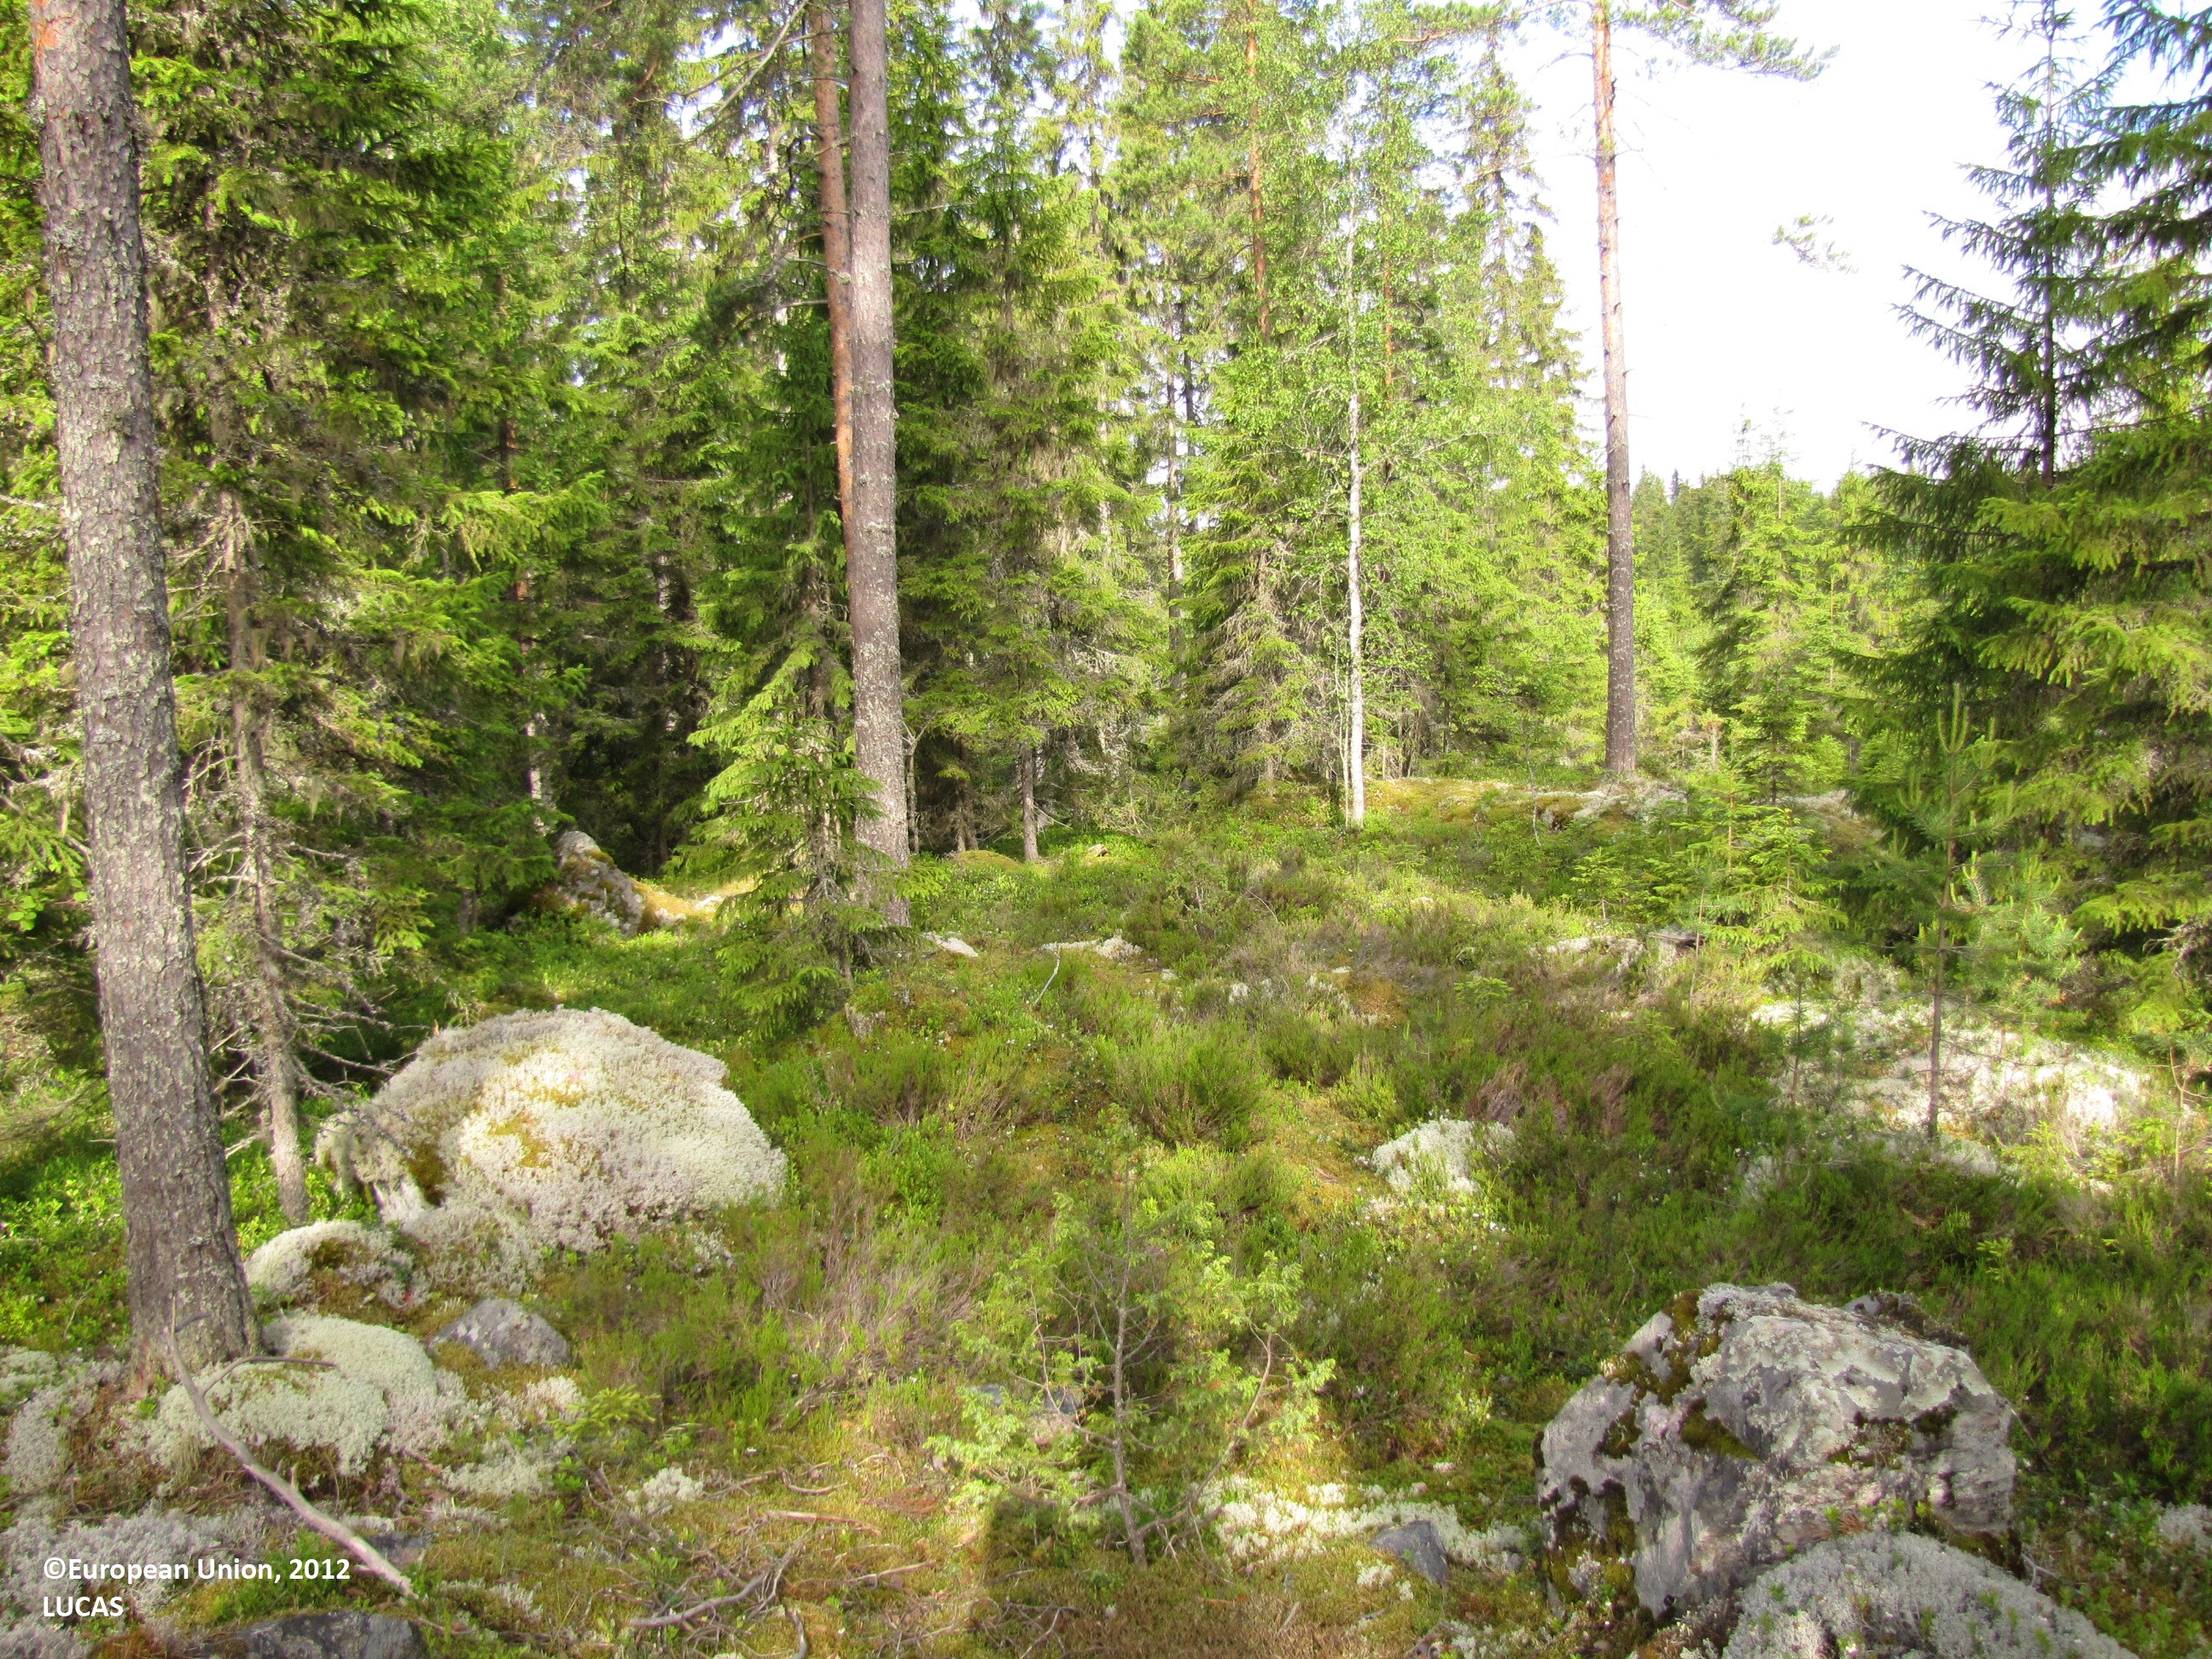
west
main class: Woodland
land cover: Pine dominated coniferous woodland
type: boreal forest
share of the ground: 50 - 75 %
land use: Forestry
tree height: > 5 m
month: June
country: FI
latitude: 61.7180
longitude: 24.5327
